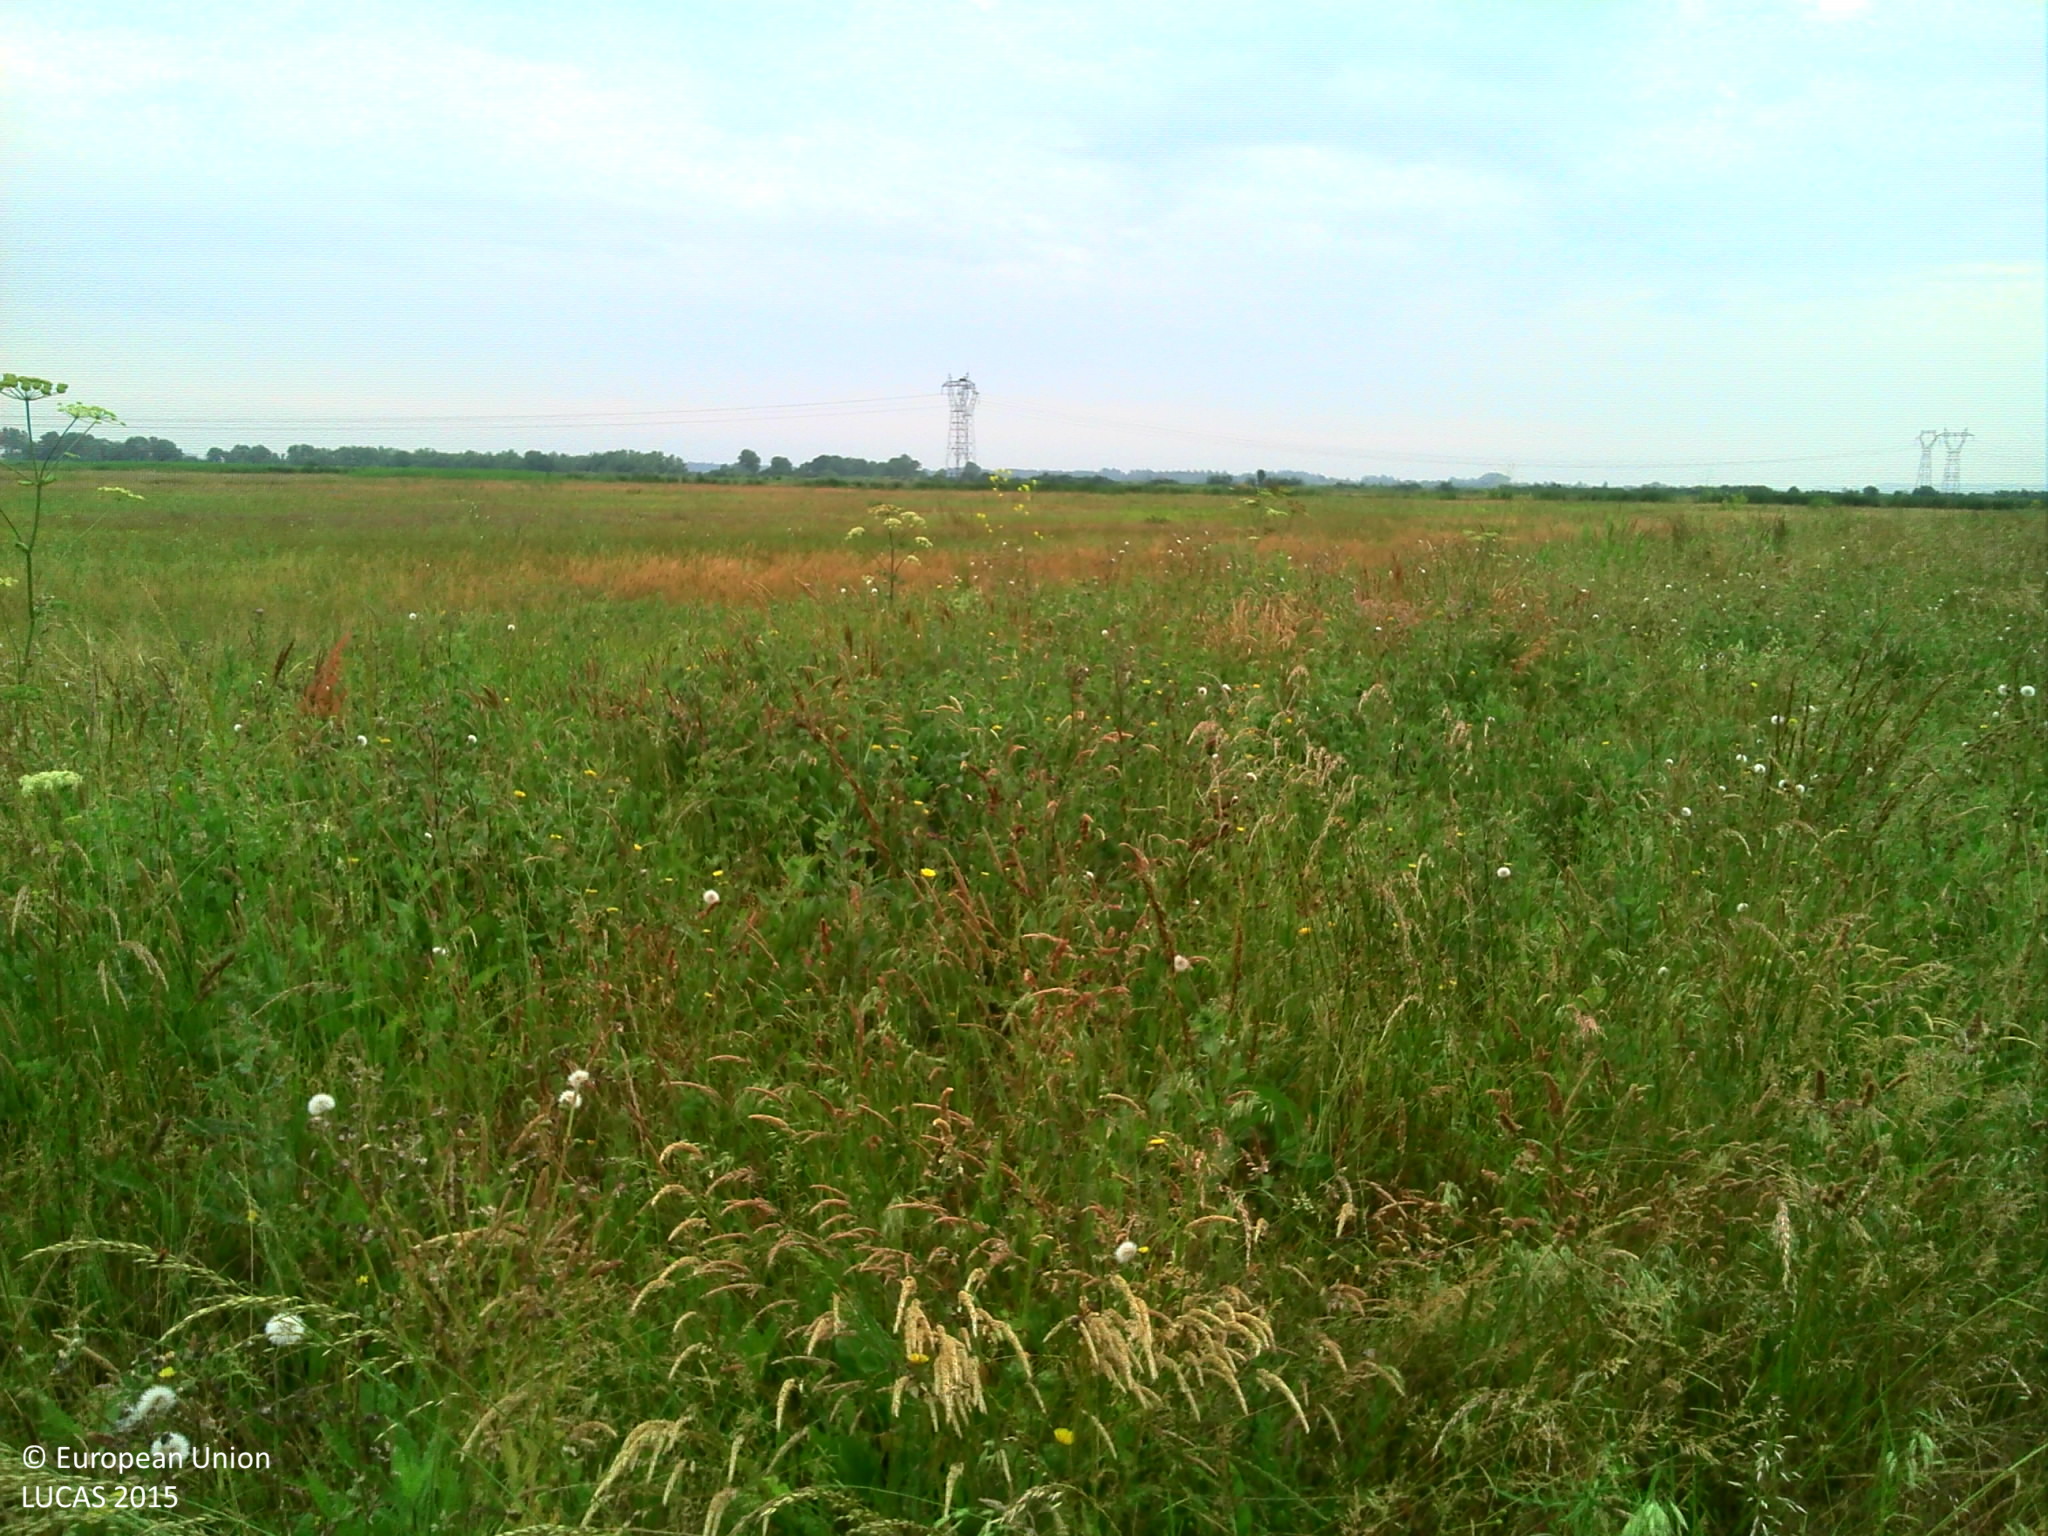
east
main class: Grassland
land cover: Grassland without tree/shrub cover
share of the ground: > 75 %
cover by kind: herbaceous plants 95 %, shrubs 5 %
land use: Agriculture (excluding fallow land and kitchen gardens)
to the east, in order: Grassland without tree/shrub cover; Tracks; Grassland without tree/shrub cover; Ditches and canals; Grassland without tree/shrub cover; Ditches and canals; Grassland without tree/shrub cover; Ditches and canals; Grassland without tree/shrub cover; Ditches and canals; Grassland without tree/shrub cover; Ditches and canals; Grassland without tree/shrub cover; Inland fresh running water
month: June
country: FR
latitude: 46.0089
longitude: -0.9154
